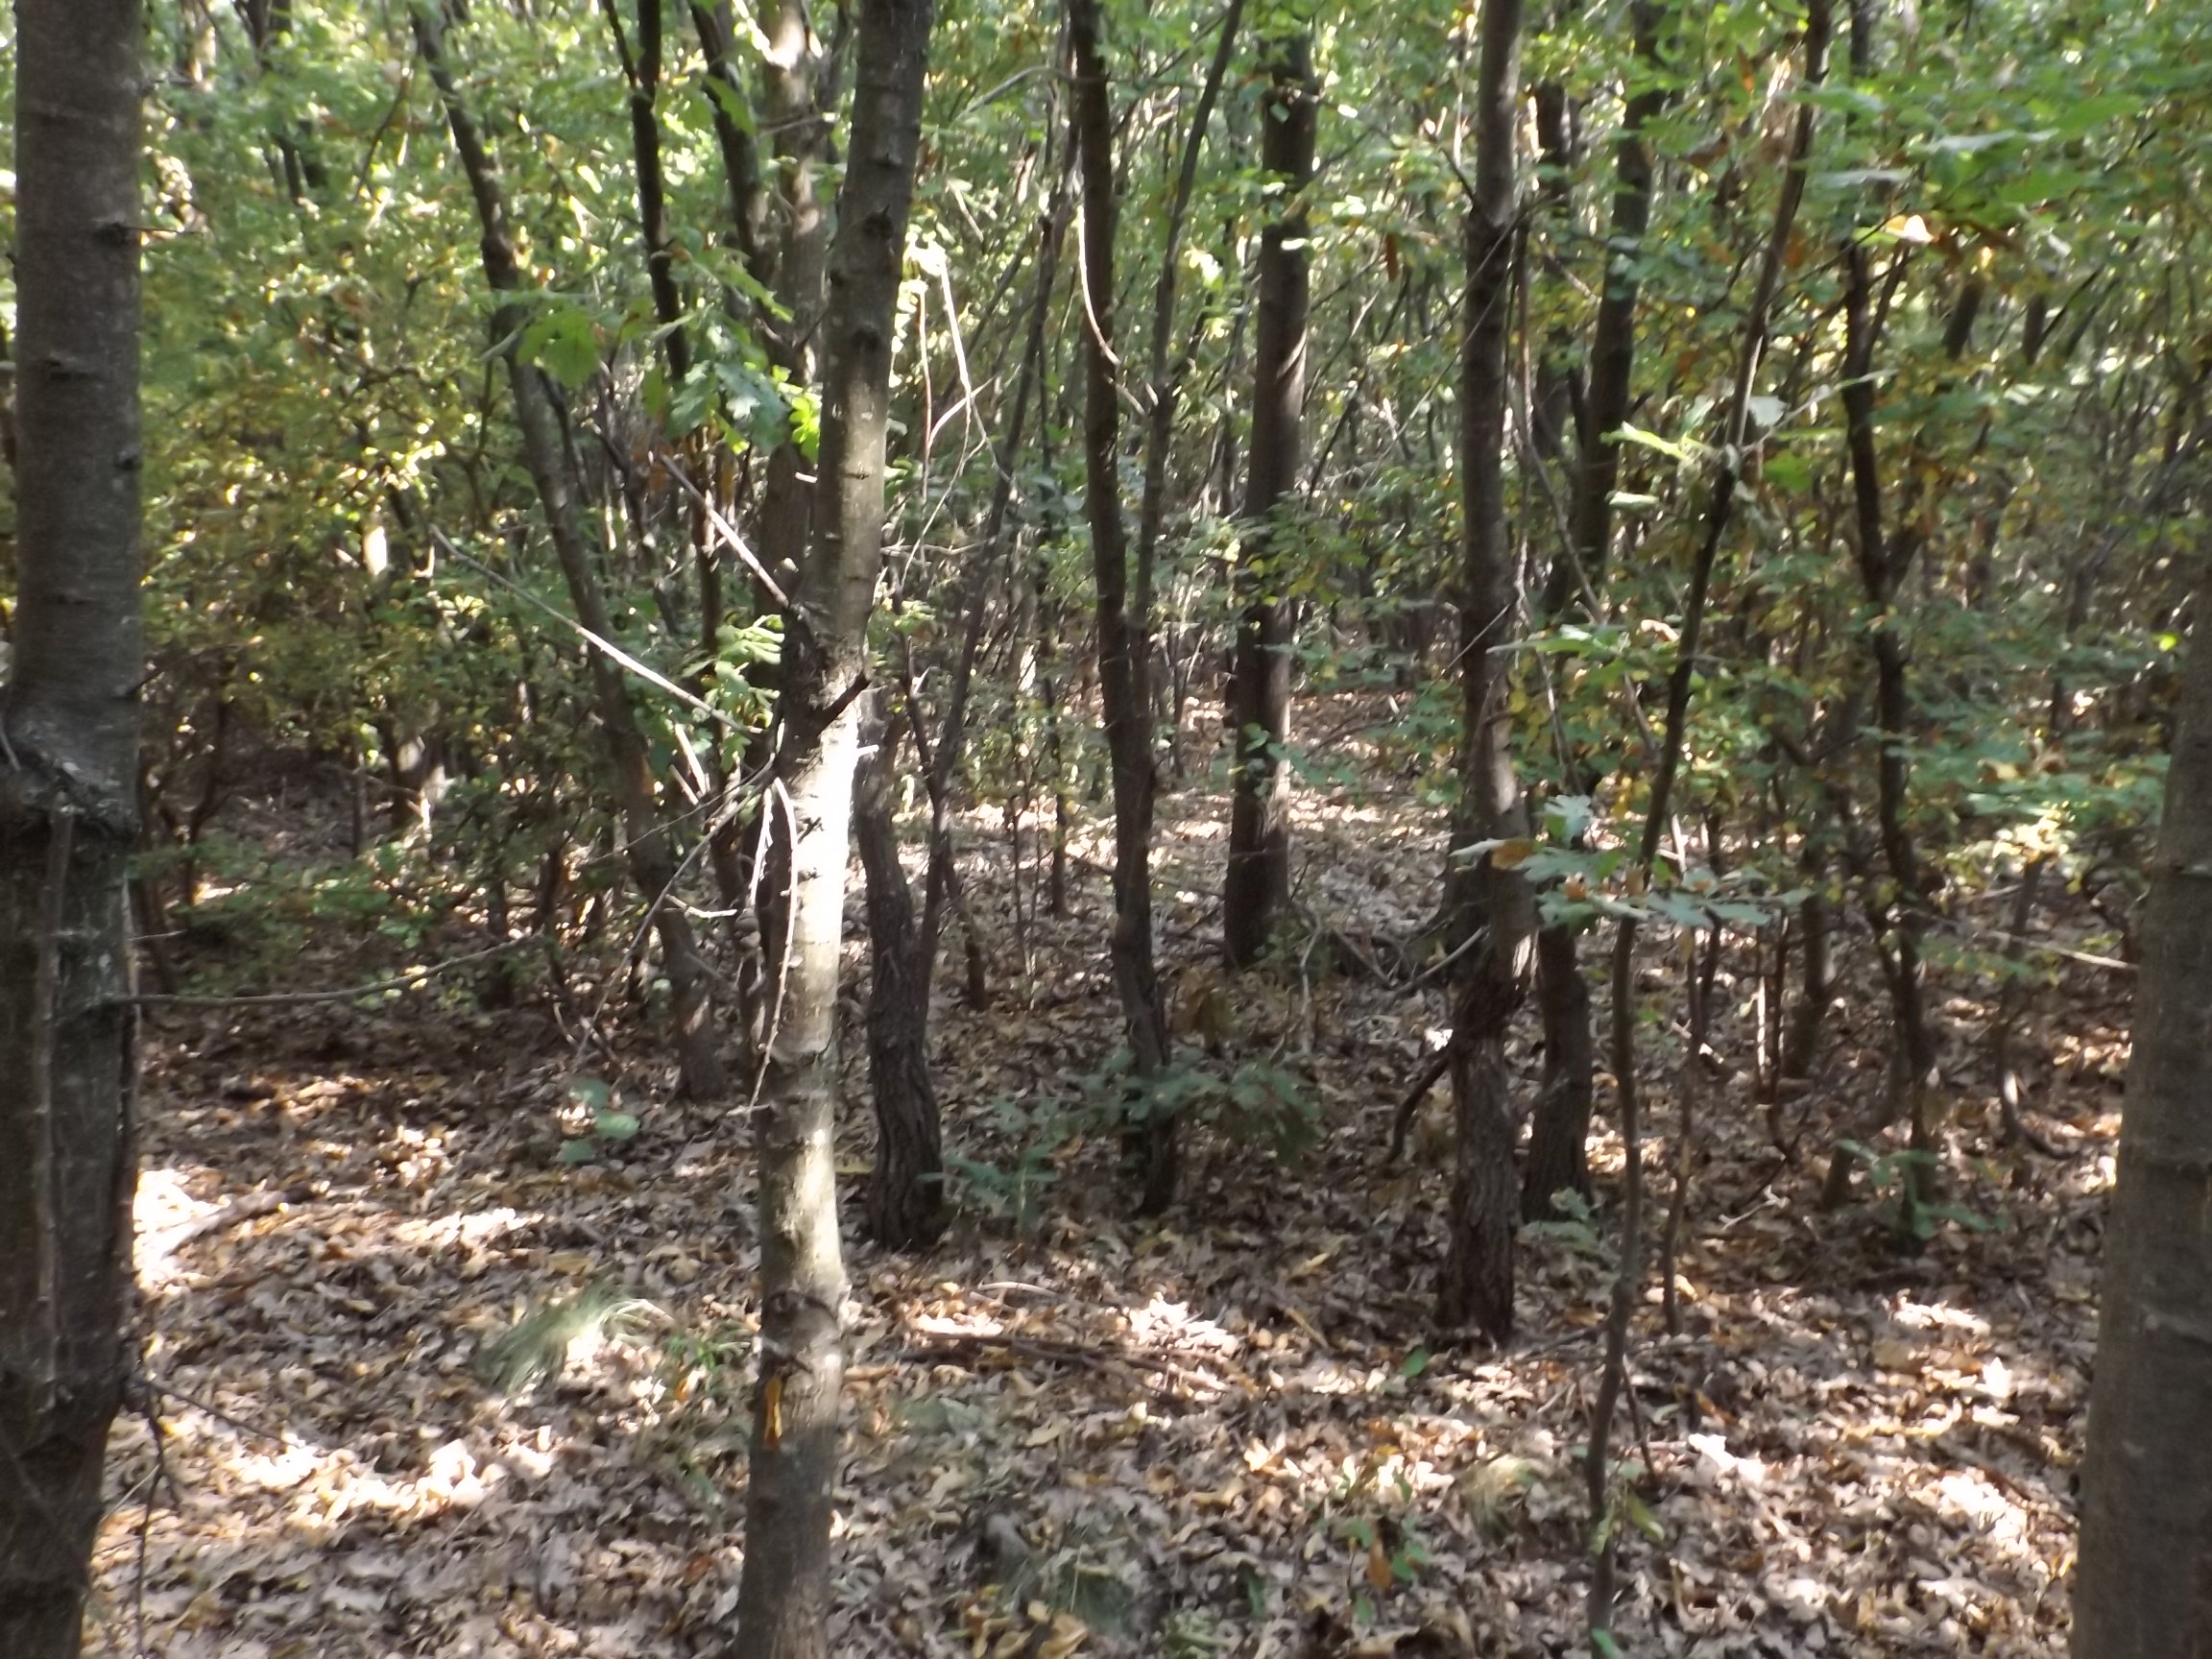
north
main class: Woodland
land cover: Broadleaved woodland
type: mesophytic deciduous forest
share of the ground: > 75 %
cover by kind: broadleaved forest trees 95 %, herbaceous plants 5 %
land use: Forestry
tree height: > 5 m
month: July
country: BG
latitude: 43.4790
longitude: 27.3739
